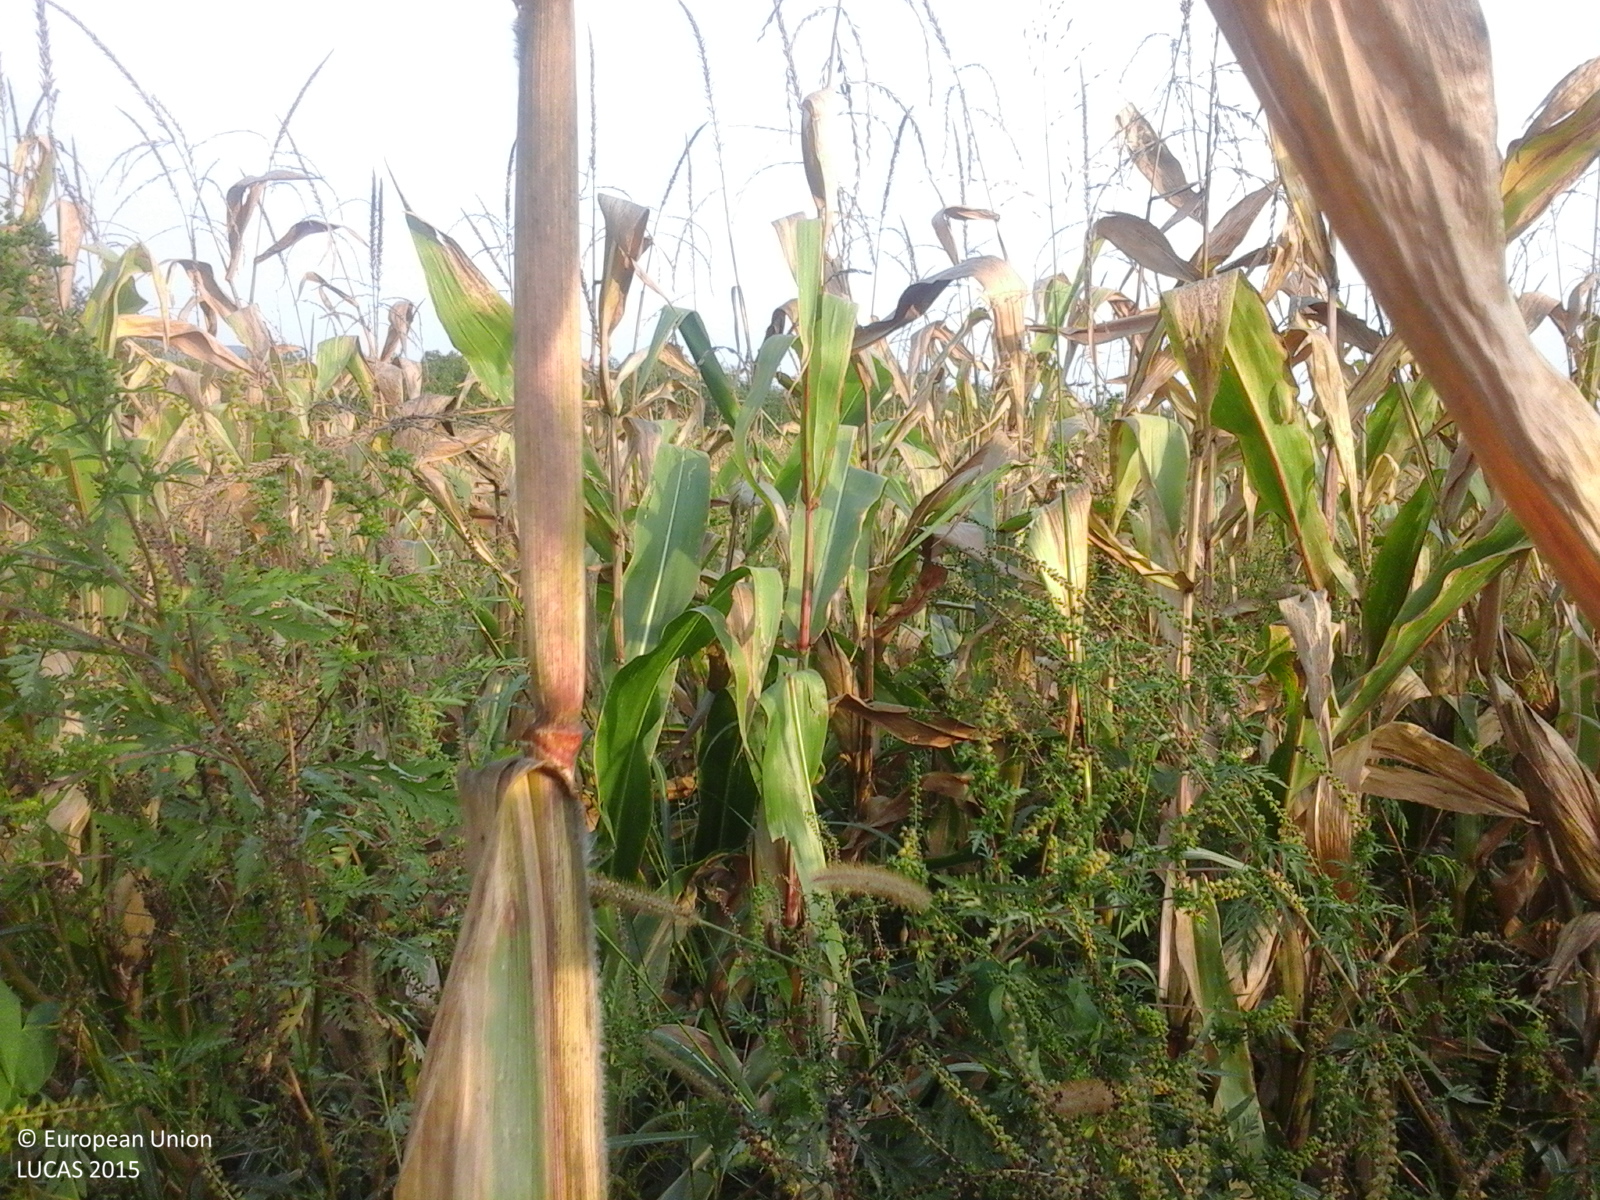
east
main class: Cropland
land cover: Maize
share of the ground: > 75 %
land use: Agriculture (excluding fallow land and kitchen gardens)
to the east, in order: Maize; Spontaneously vegetated surfaces; Maize; Fences; Lines of trees; Maize; Other fresh vegetables; Artificial constructions in urban areas
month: September
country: RO
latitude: 45.5471
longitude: 22.1446
